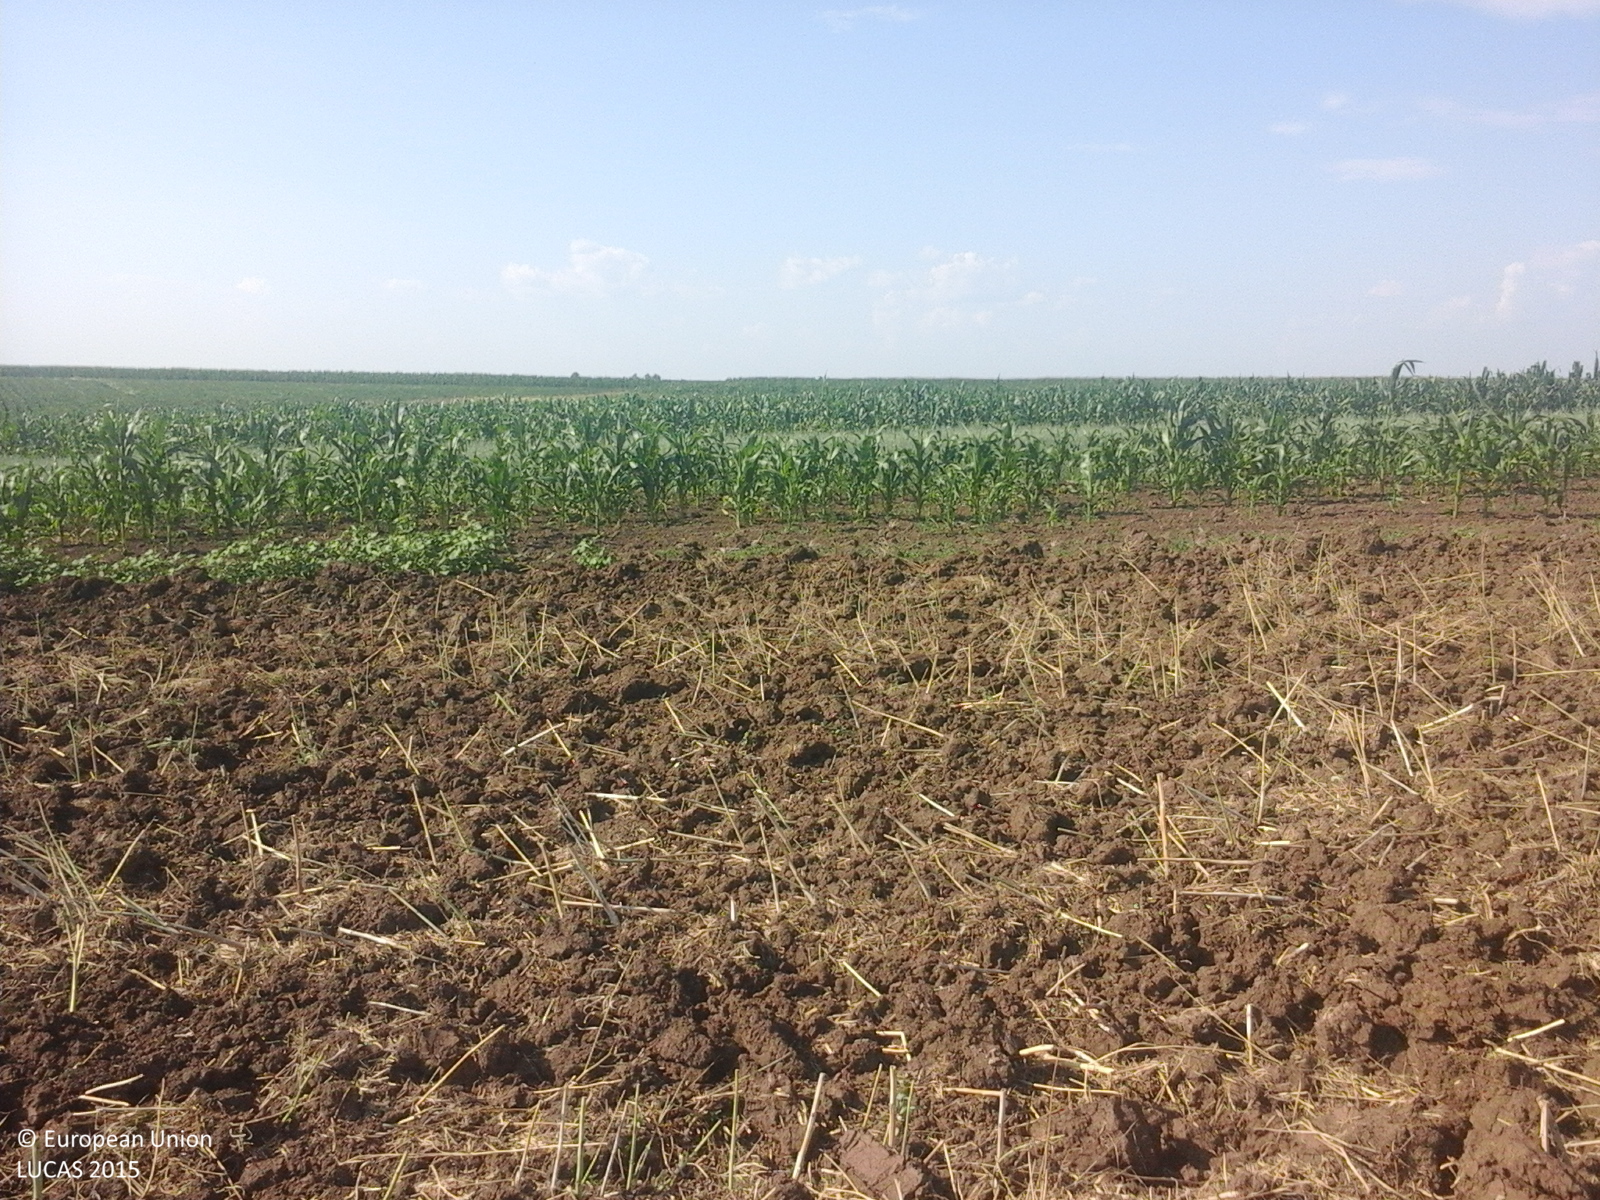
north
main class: Cropland
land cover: Rape and turnip rape
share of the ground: < 10 %
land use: Agriculture (excluding fallow land and kitchen gardens)
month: July
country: RO
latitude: 44.6173
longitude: 24.4246
